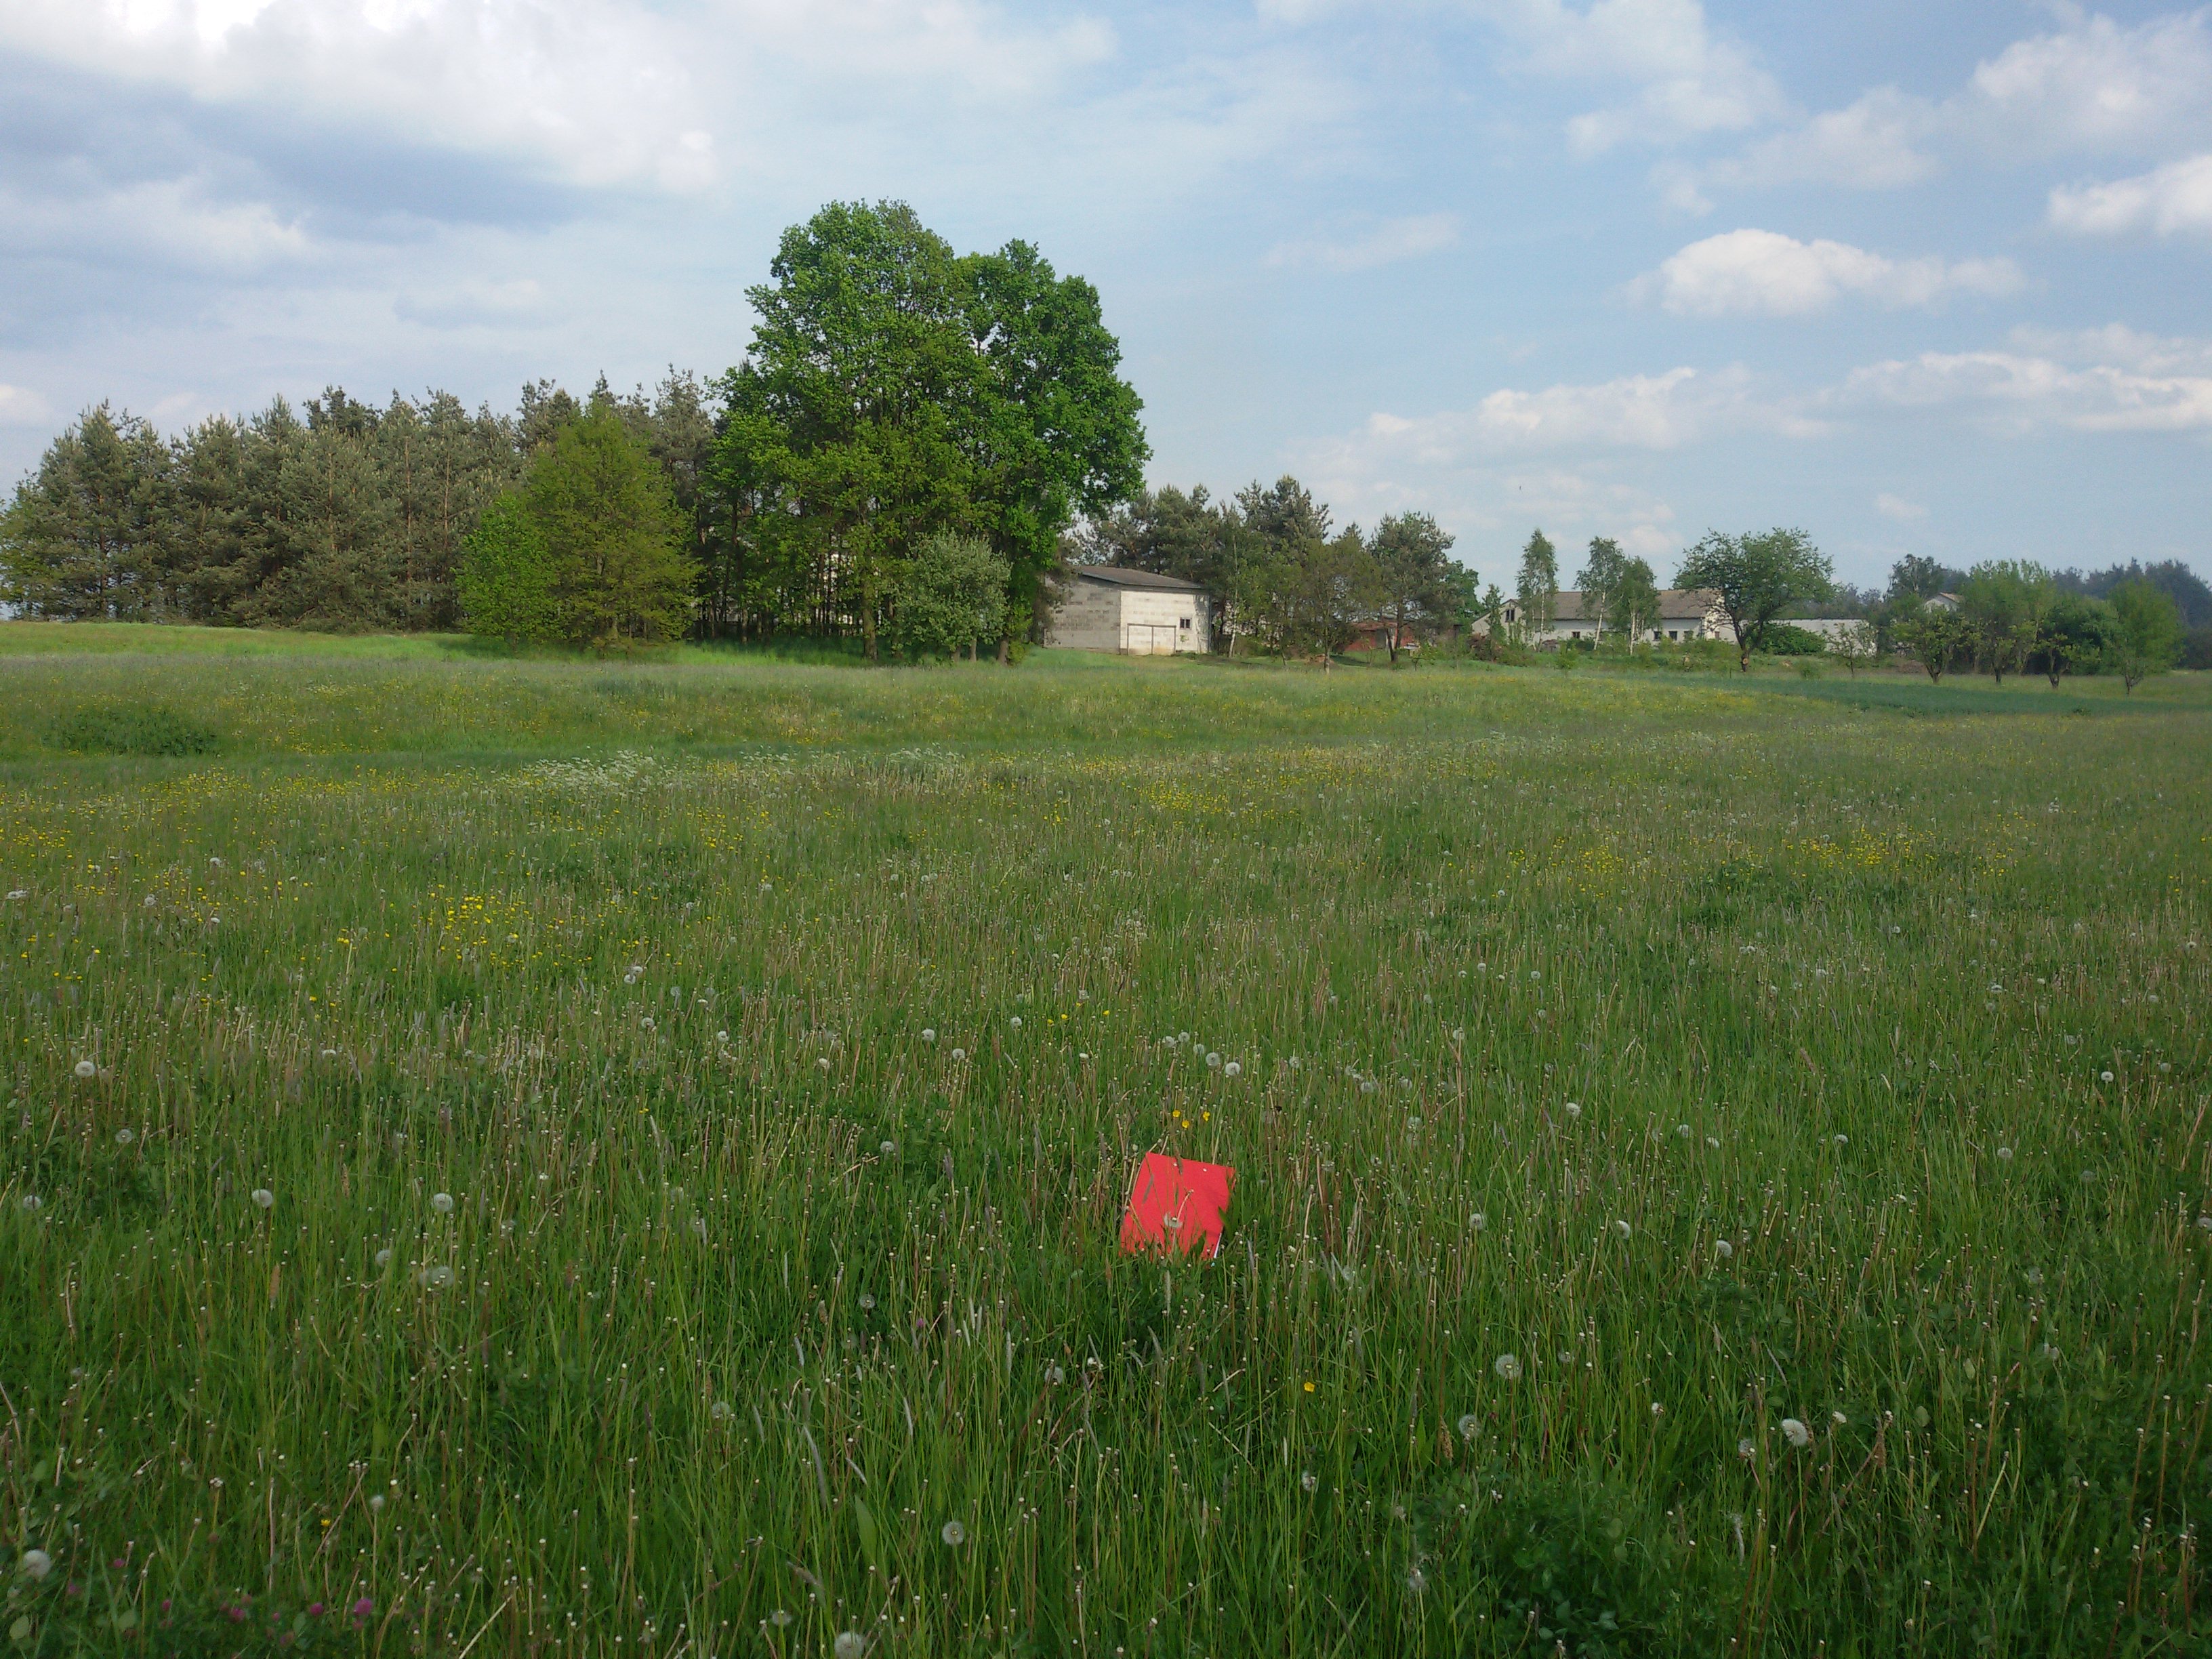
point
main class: Grassland
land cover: Grassland without tree/shrub cover
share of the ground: > 75 %
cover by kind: herbaceous plants 100 %
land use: Agriculture (excluding fallow land and kitchen gardens)
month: May
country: PL
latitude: 51.6197
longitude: 21.6514
